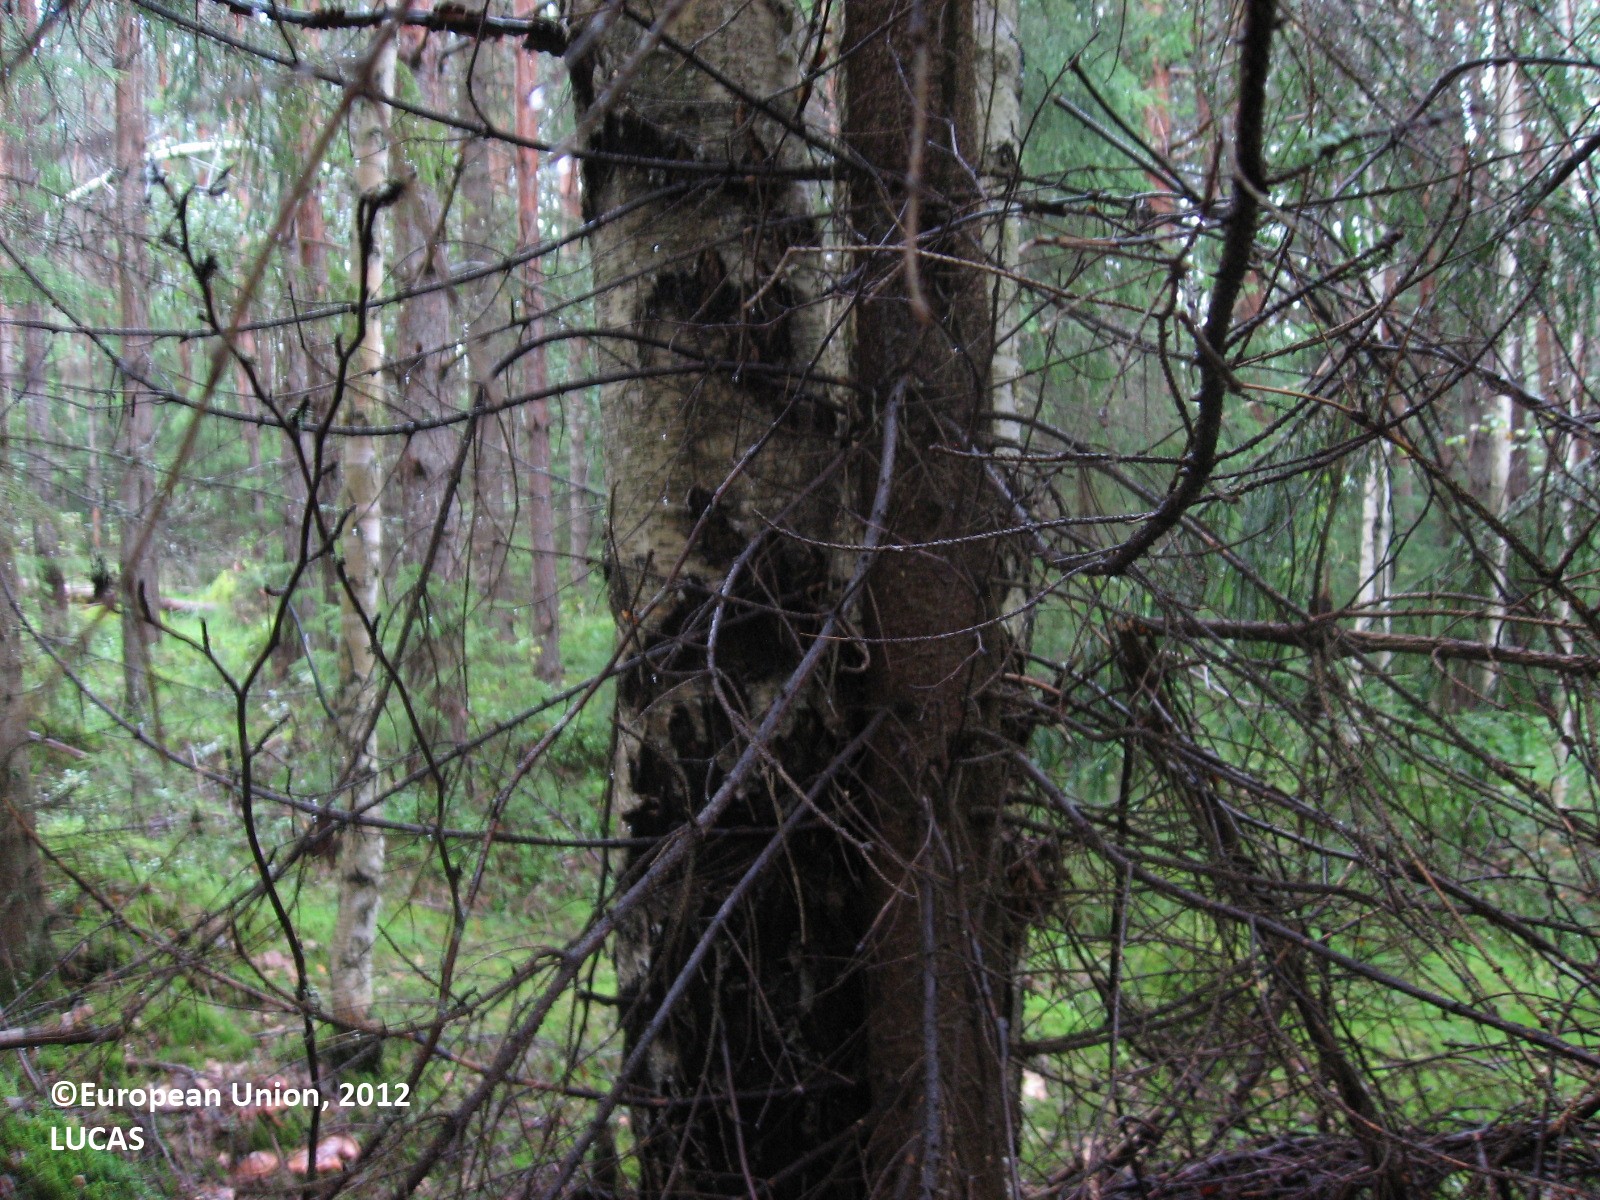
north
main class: Woodland
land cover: Spruce dominated mixed woodland
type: boreal forest
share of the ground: > 75 %
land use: Forestry
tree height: > 5 m
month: August
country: FI
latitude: 60.7220
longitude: 25.0942
